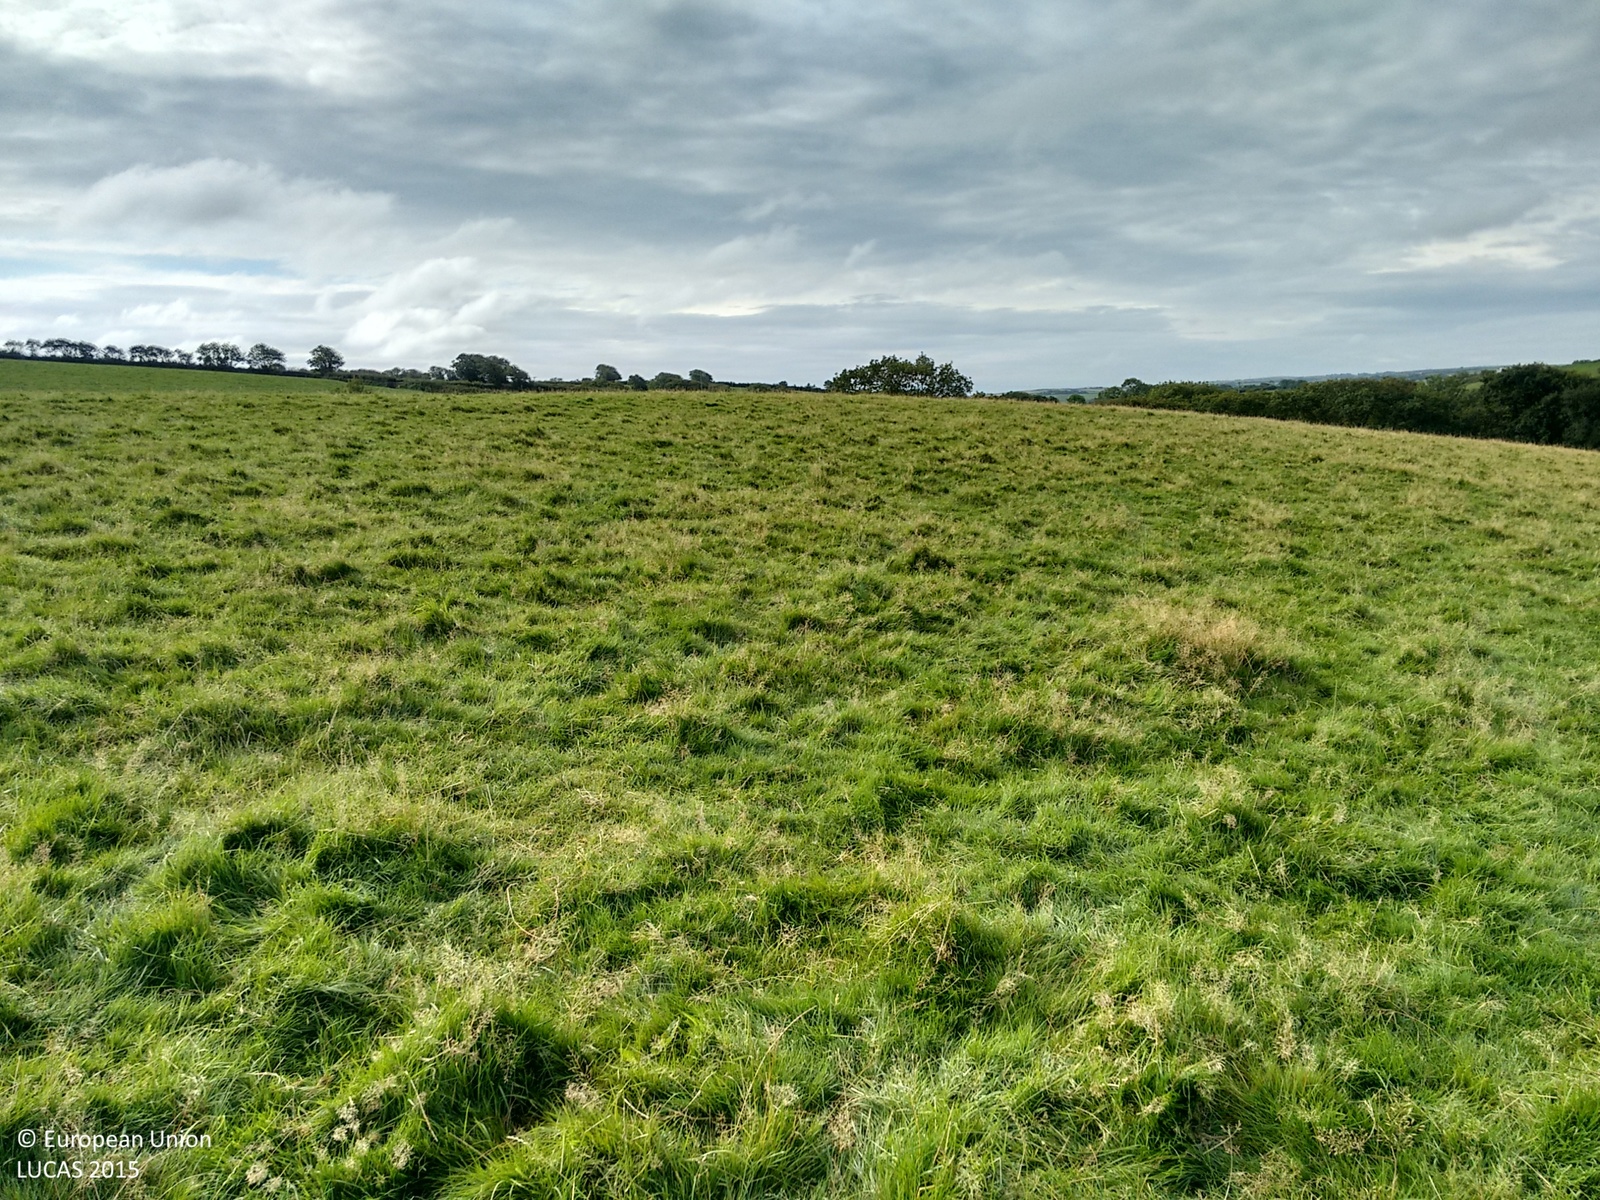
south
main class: Grassland
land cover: Grassland without tree/shrub cover
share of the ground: > 75 %
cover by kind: herbaceous plants 100 %
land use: Agriculture (excluding fallow land and kitchen gardens)
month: September
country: GB
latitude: 50.7155
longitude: -4.4798
